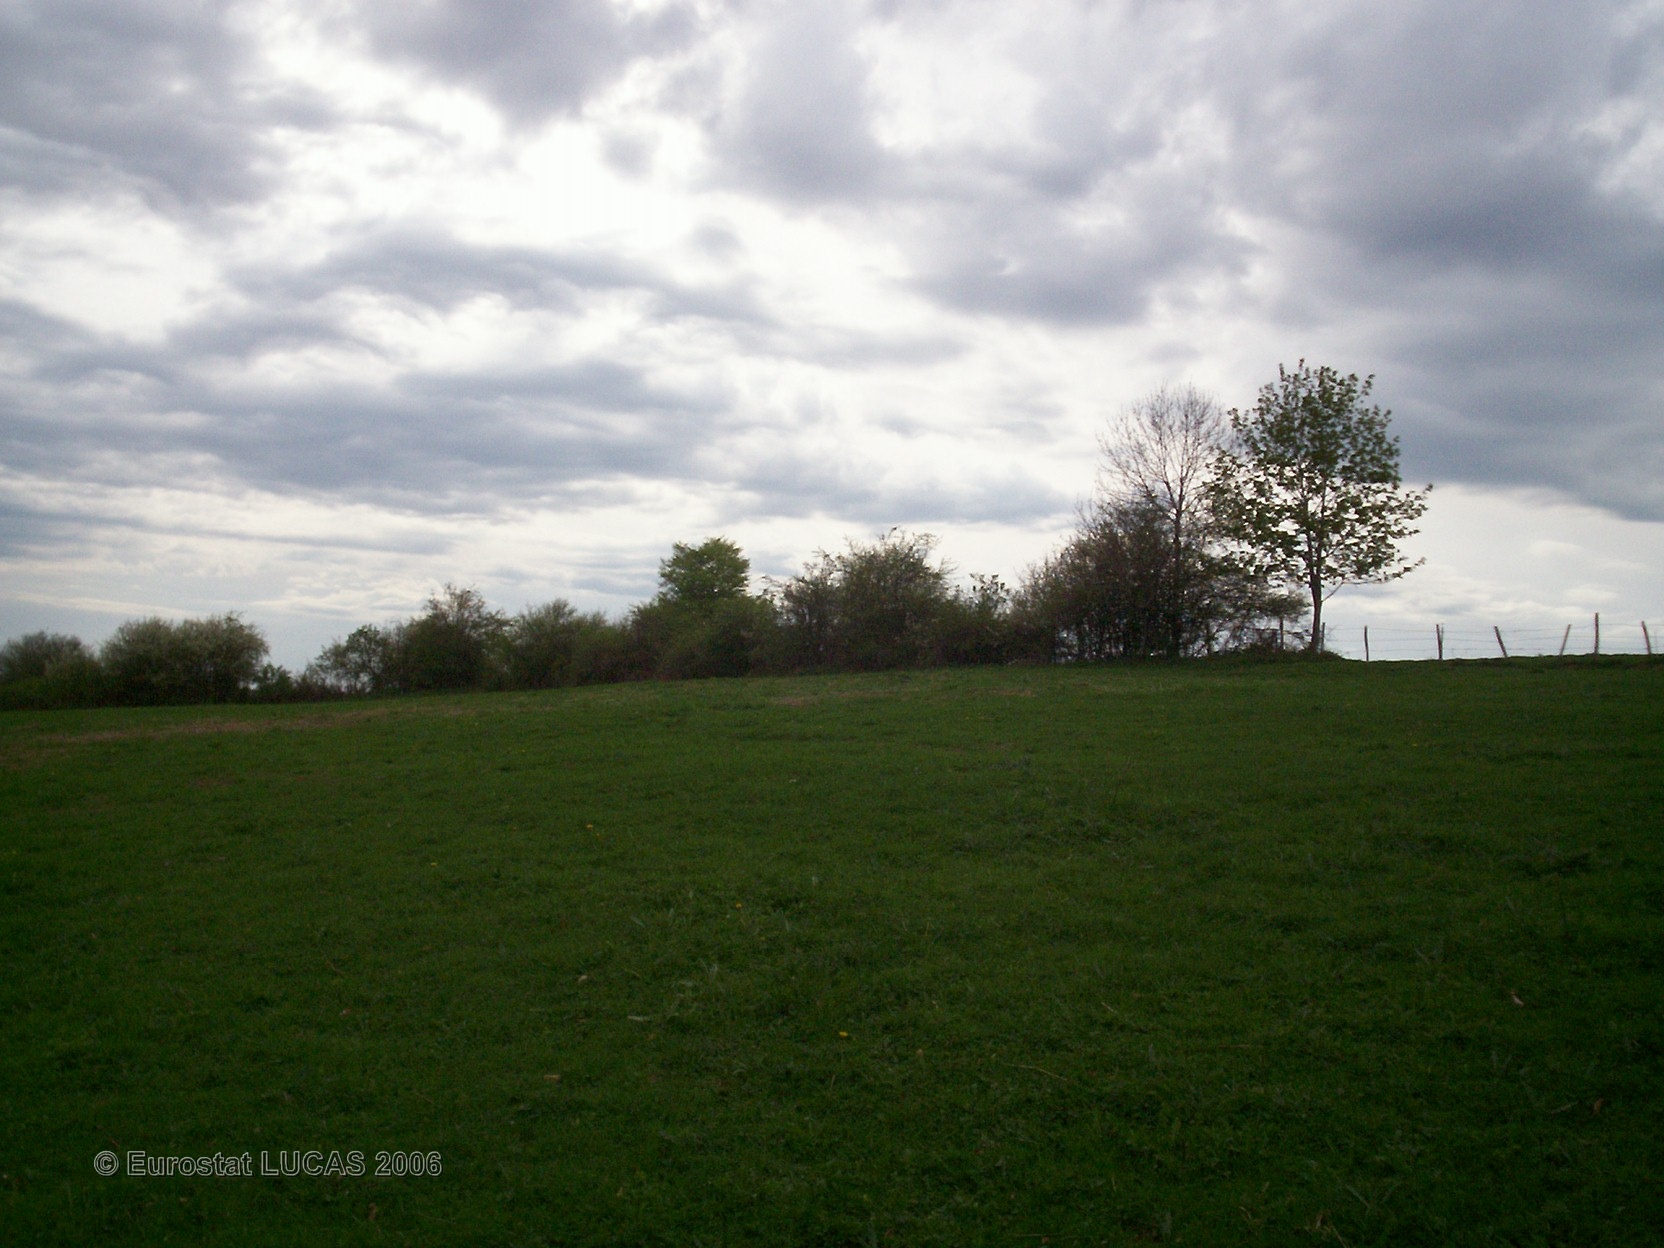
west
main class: Grassland
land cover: Grassland without tree/shrub cover
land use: Agriculture (excluding fallow land and kitchen gardens)
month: May
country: FR
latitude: 47.2238
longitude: 6.8457
